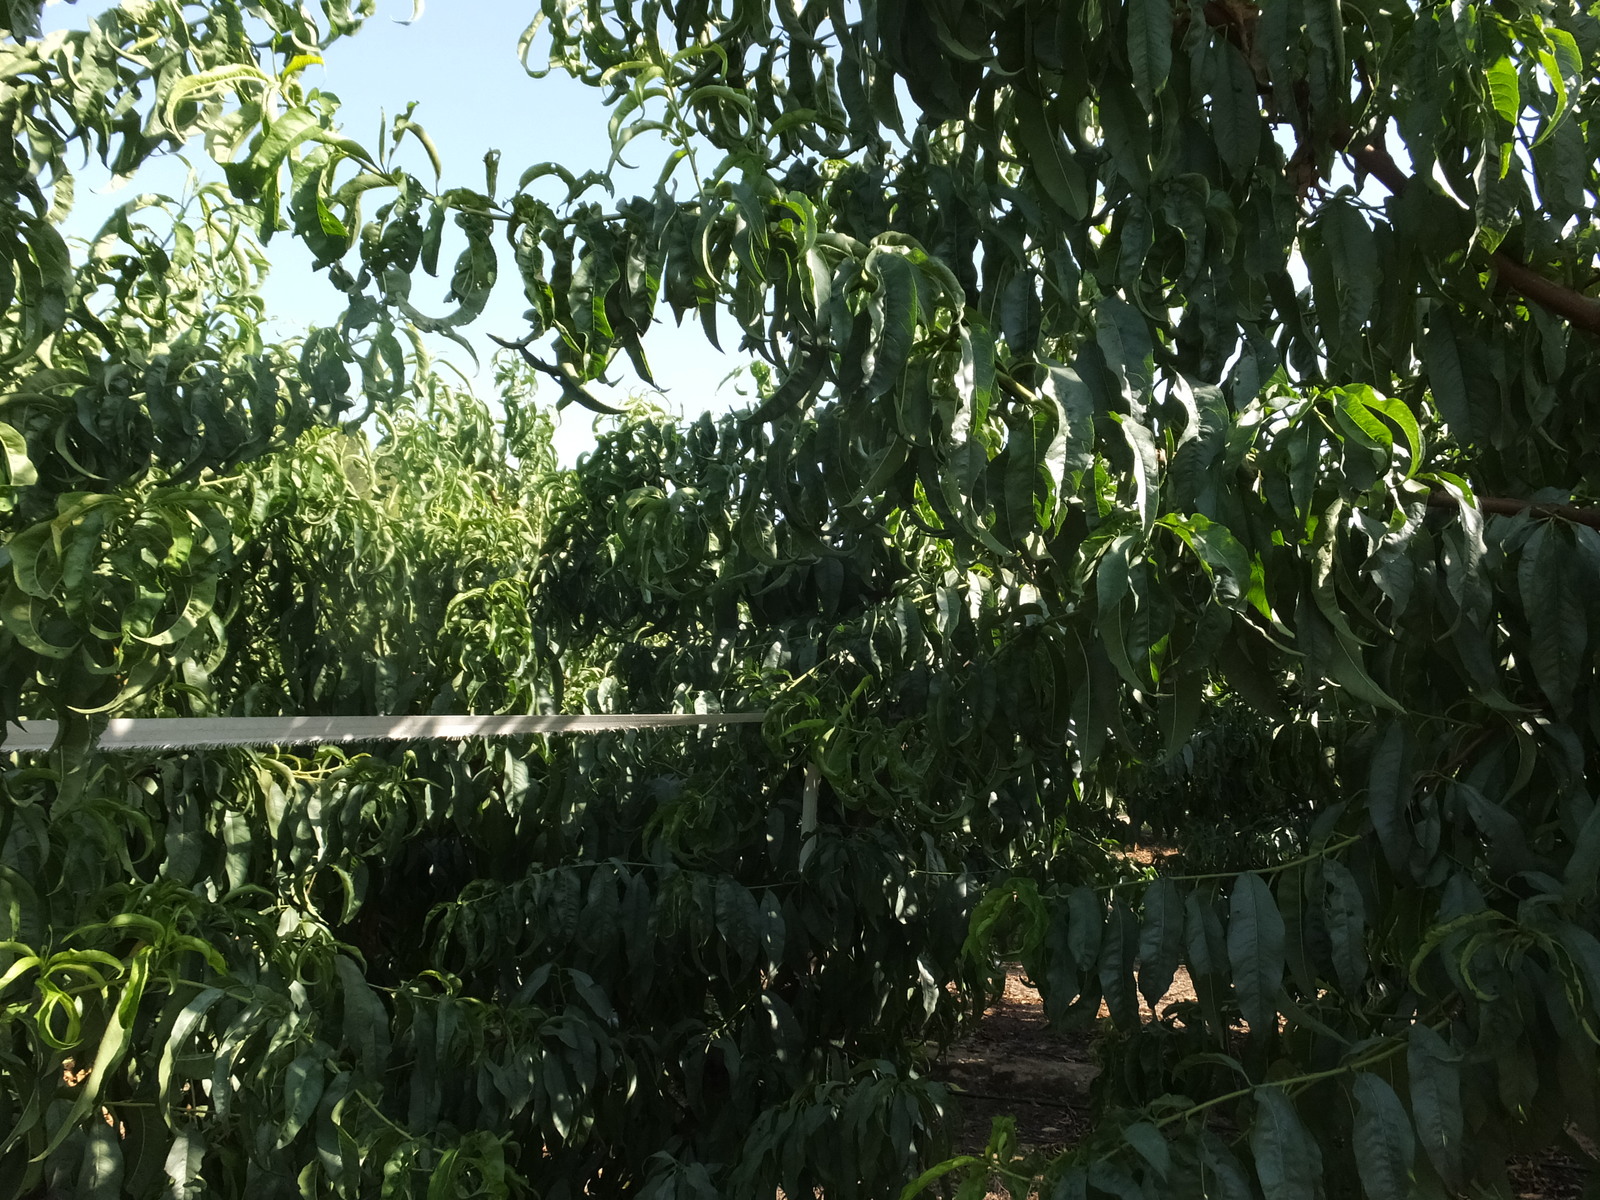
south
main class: Cropland
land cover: Other fruit trees and berries
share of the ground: 50 - 75 %
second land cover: Spontaneously vegetated surfaces
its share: 10 - 25 %
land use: Agriculture (excluding fallow land and kitchen gardens)
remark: Harvested field
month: August
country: ES
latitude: 41.6105
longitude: 0.3505
